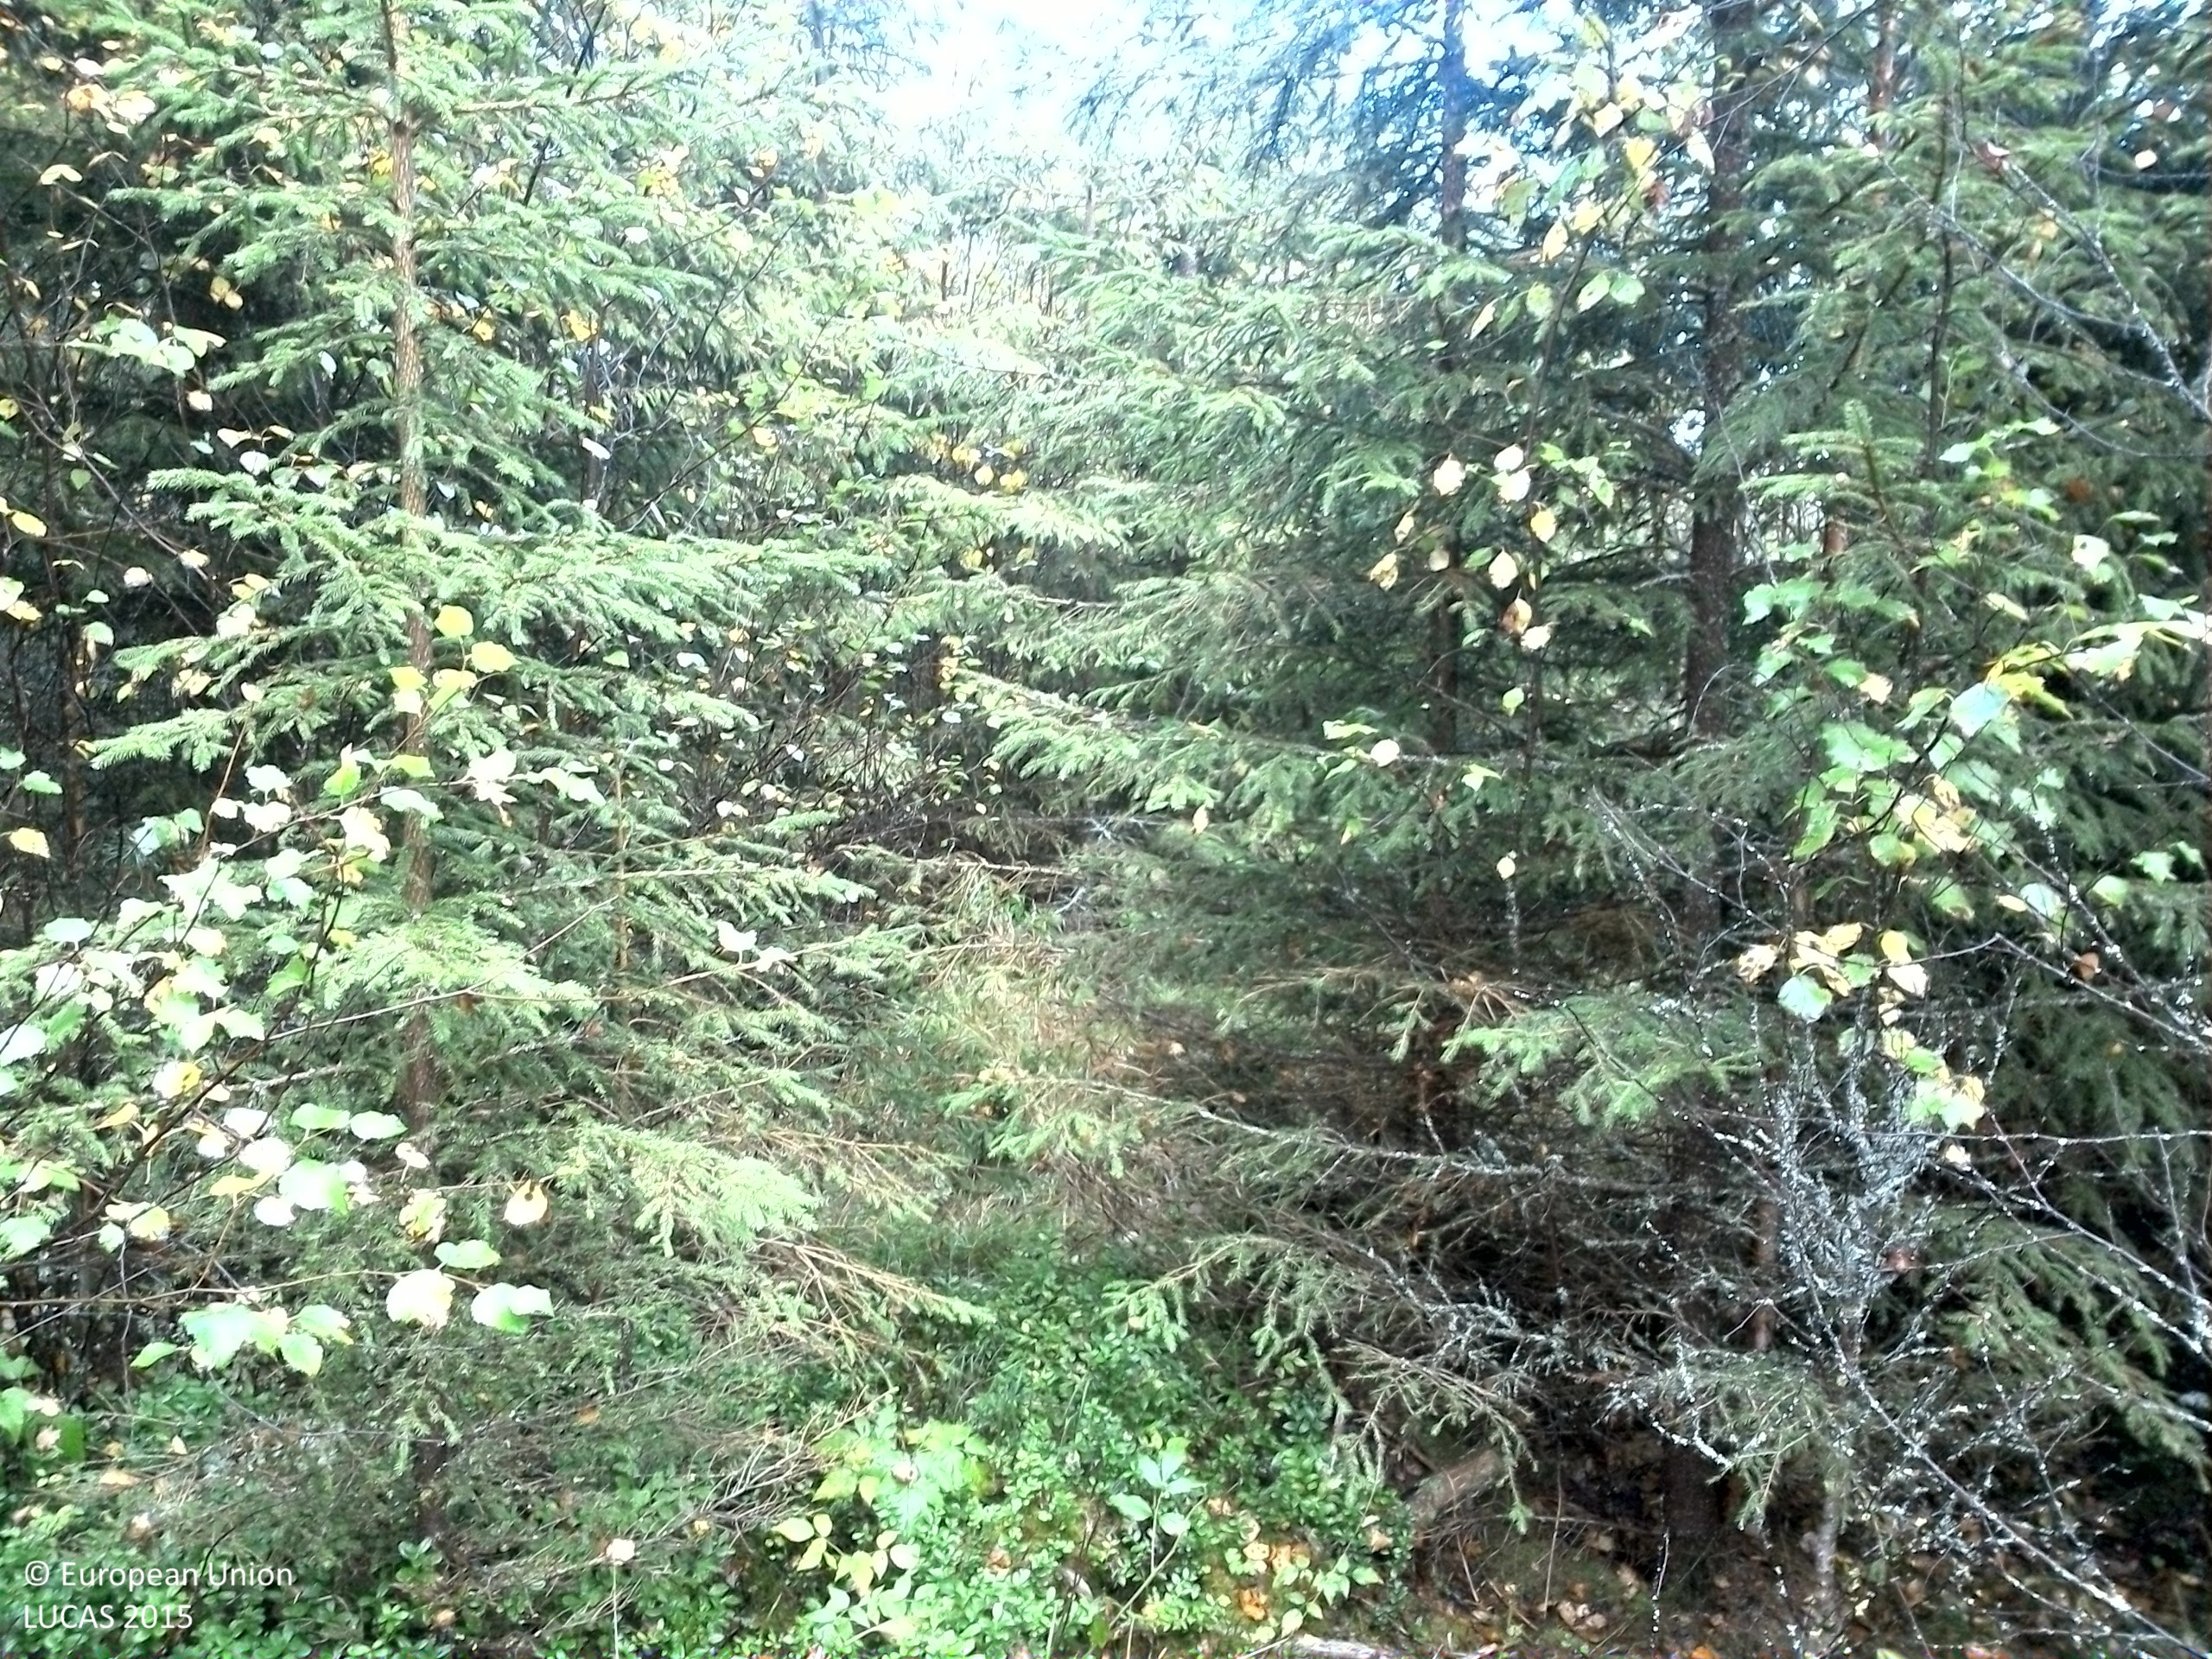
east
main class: Woodland
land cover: Spruce dominated mixed woodland
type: boreal forest
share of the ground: 50 - 75 %
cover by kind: coniferous forest trees 45 %, broadleaved forest trees 25 %, shrubs 15 %, herbaceous plants 15 %
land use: Forestry
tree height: < 5 m
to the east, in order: Spruce dominated mixed woodland; Spruce dominated coniferous woodland; Ditches and canals; Spruce dominated coniferous woodland; Spruce dominated mixed woodland; Other mixed woodland
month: September
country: SE
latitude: 61.1753
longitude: 14.9871
